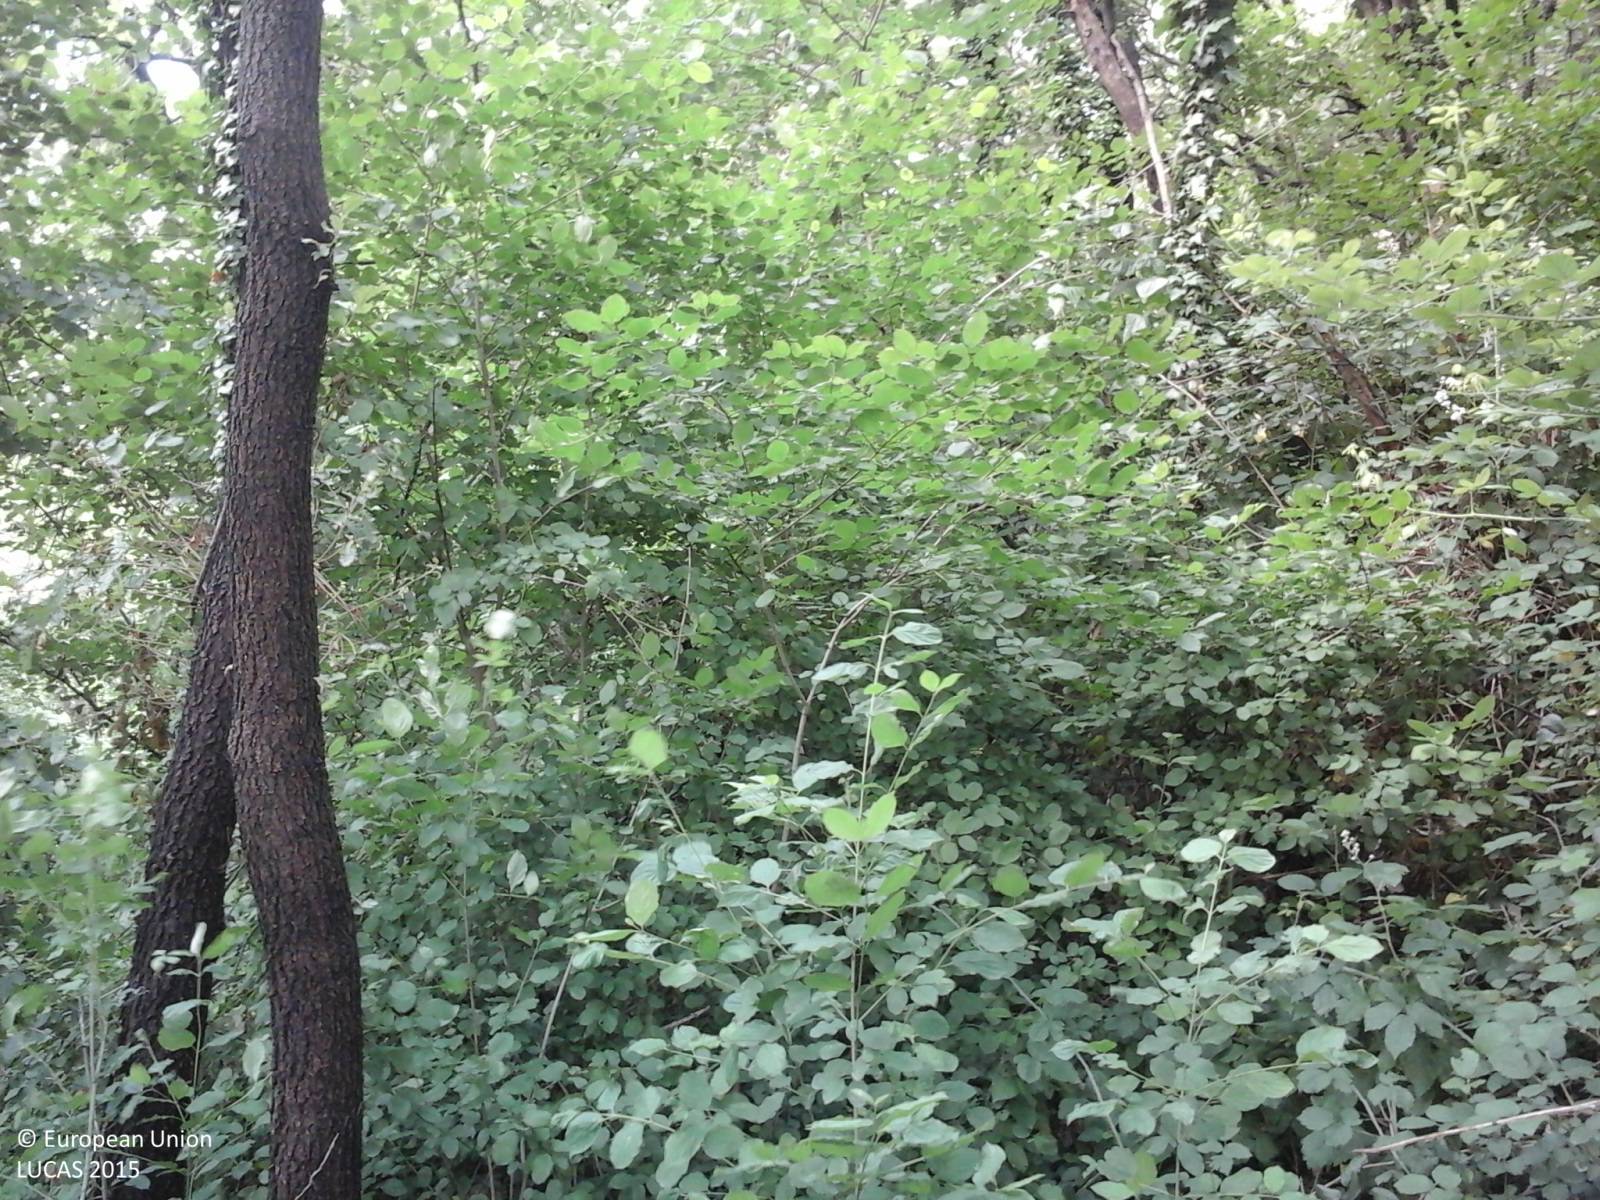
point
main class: Woodland
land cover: Broadleaved woodland
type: thermophilous deciduous forest
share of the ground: > 75 %
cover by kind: broadleaved forest trees 70 %, shrubs 20 %, herbaceous plants 10 %
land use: Forestry
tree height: > 5 m
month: June
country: IT
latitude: 46.1458
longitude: 13.0390
